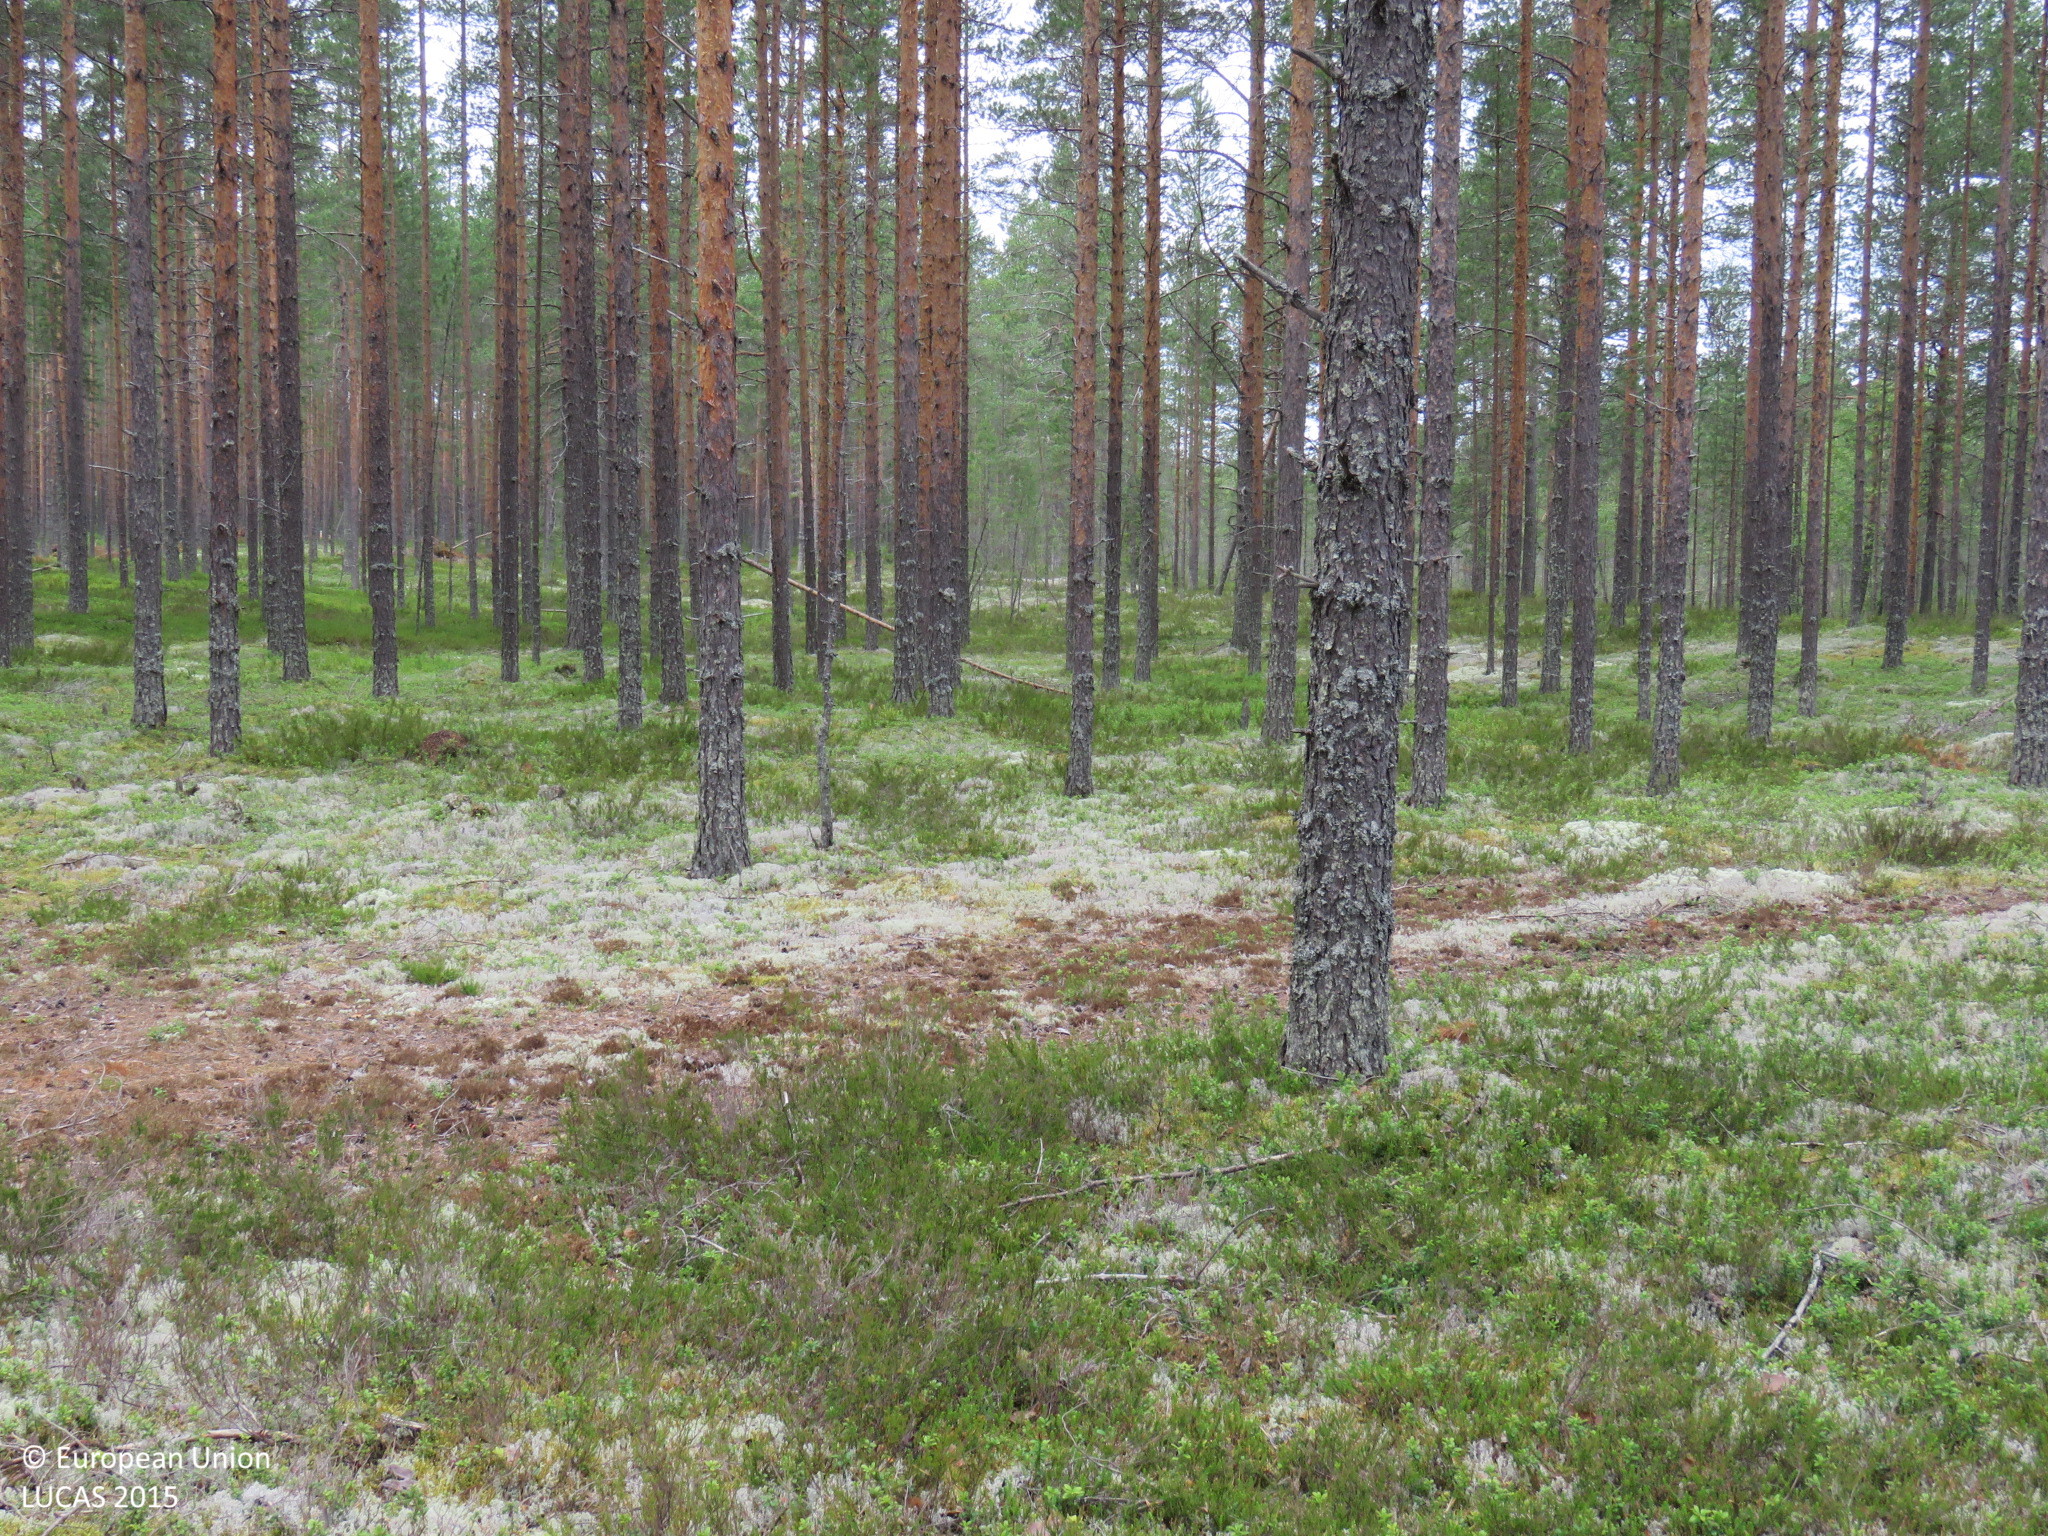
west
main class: Woodland
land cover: Pine dominated coniferous woodland
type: boreal forest
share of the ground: > 75 %
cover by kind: coniferous forest trees 75 %, lichens and mosses 15 %, shrubs 10 %
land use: Forestry
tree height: > 5 m
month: July
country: FI
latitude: 64.2591
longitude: 26.3975
